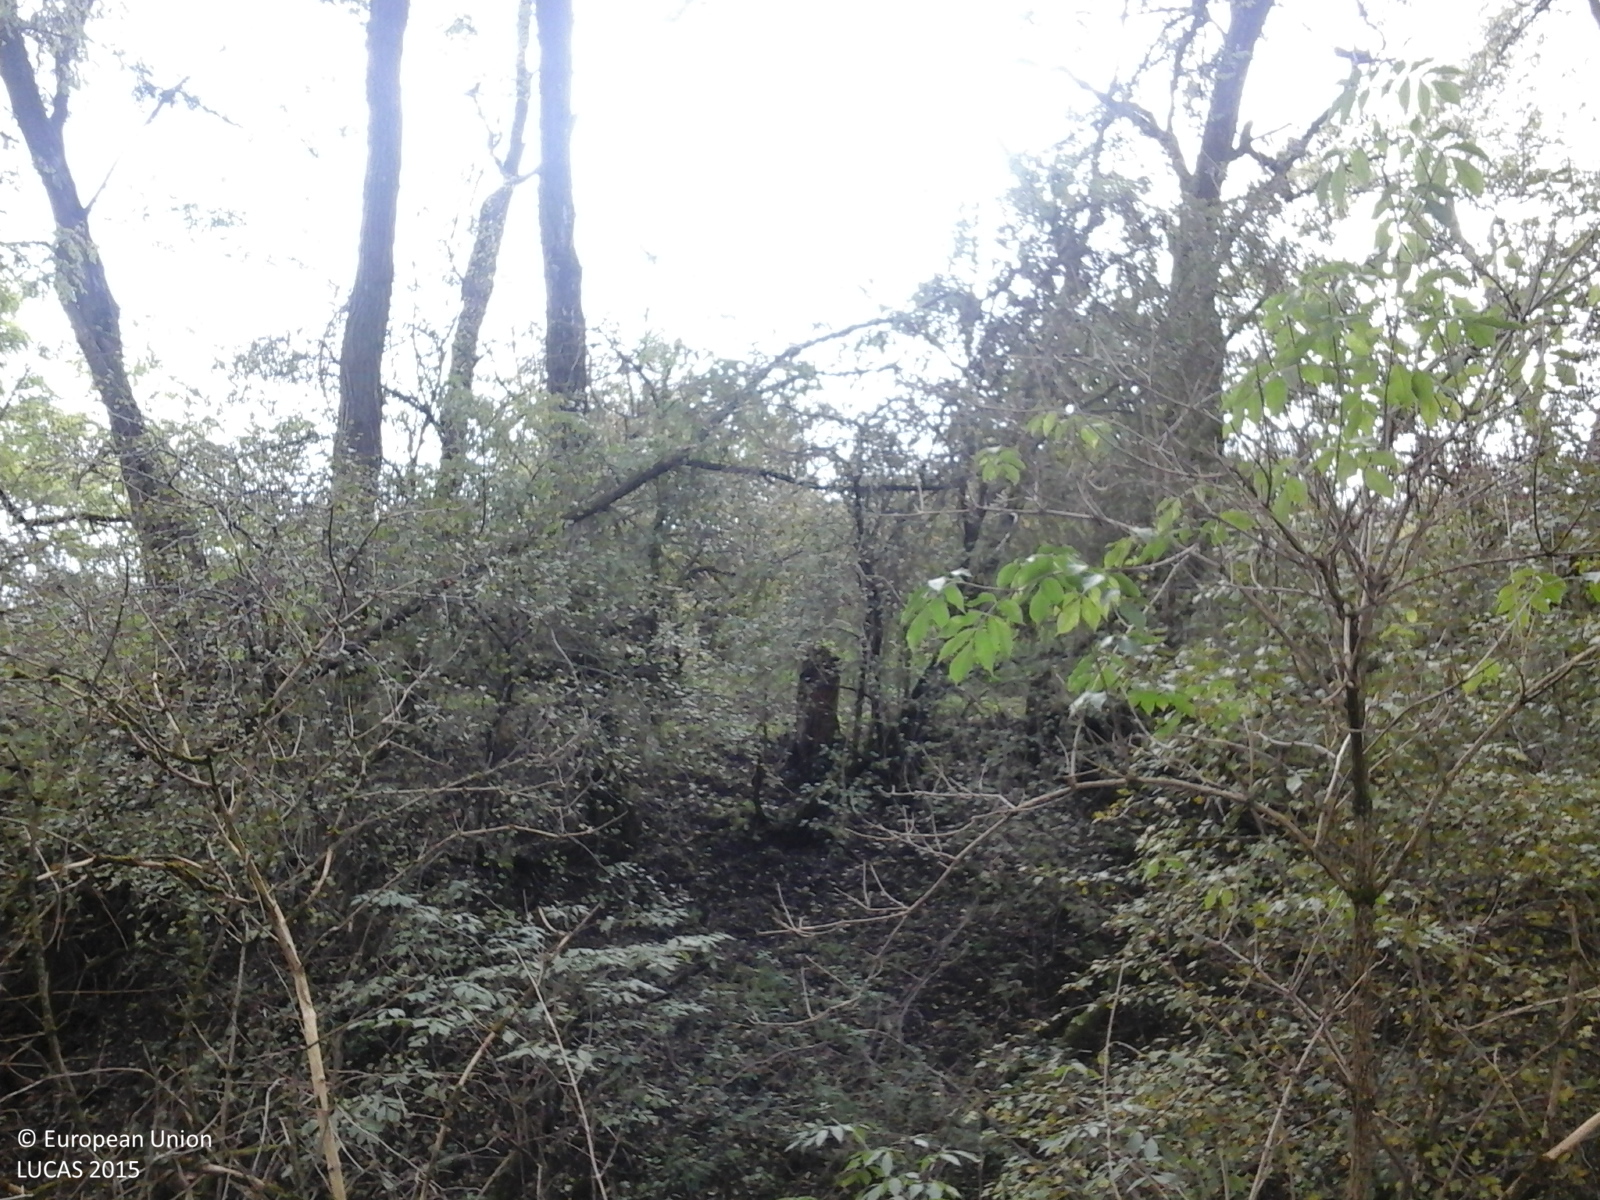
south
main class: Woodland
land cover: Broadleaved woodland
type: exotic forest
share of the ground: > 75 %
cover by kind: broadleaved forest trees 100 %
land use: Forestry
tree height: > 5 m
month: October
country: RO
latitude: 45.9045
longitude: 24.6385
